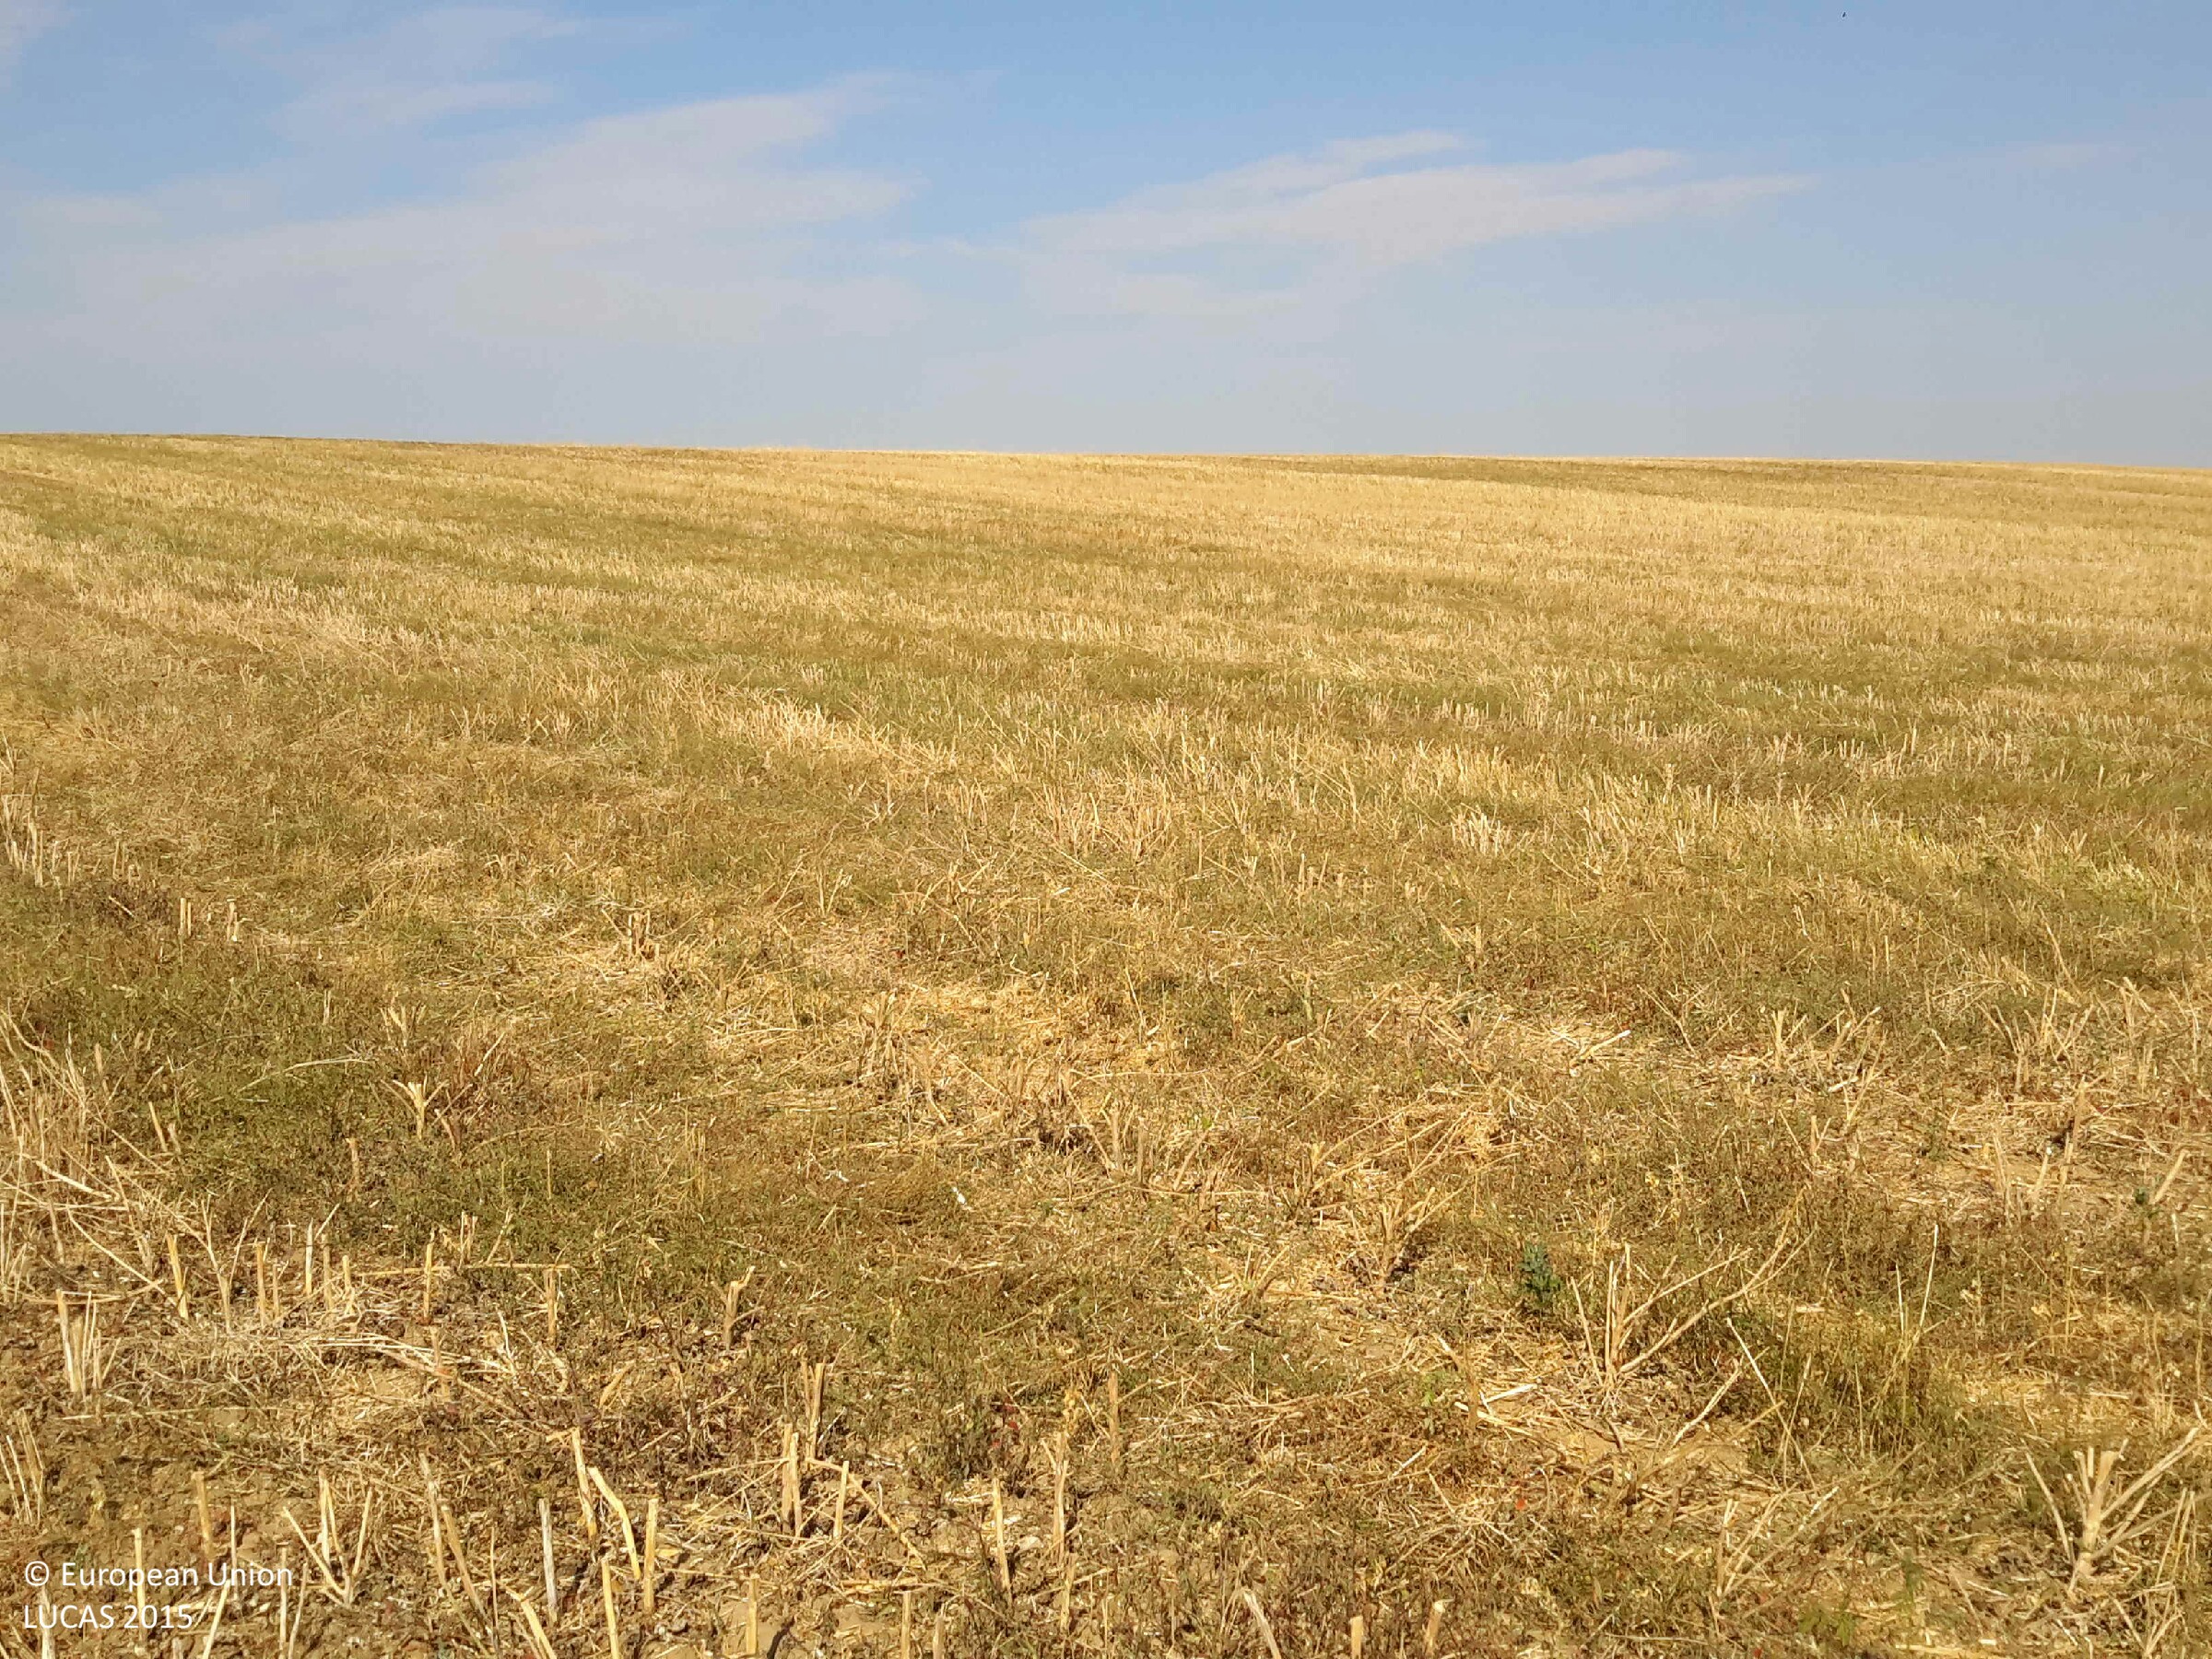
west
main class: Cropland
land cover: Rape and turnip rape
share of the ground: < 10 %
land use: Agriculture (excluding fallow land and kitchen gardens)
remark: Harvested field
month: July
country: HU
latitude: 47.4891
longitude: 17.8806
